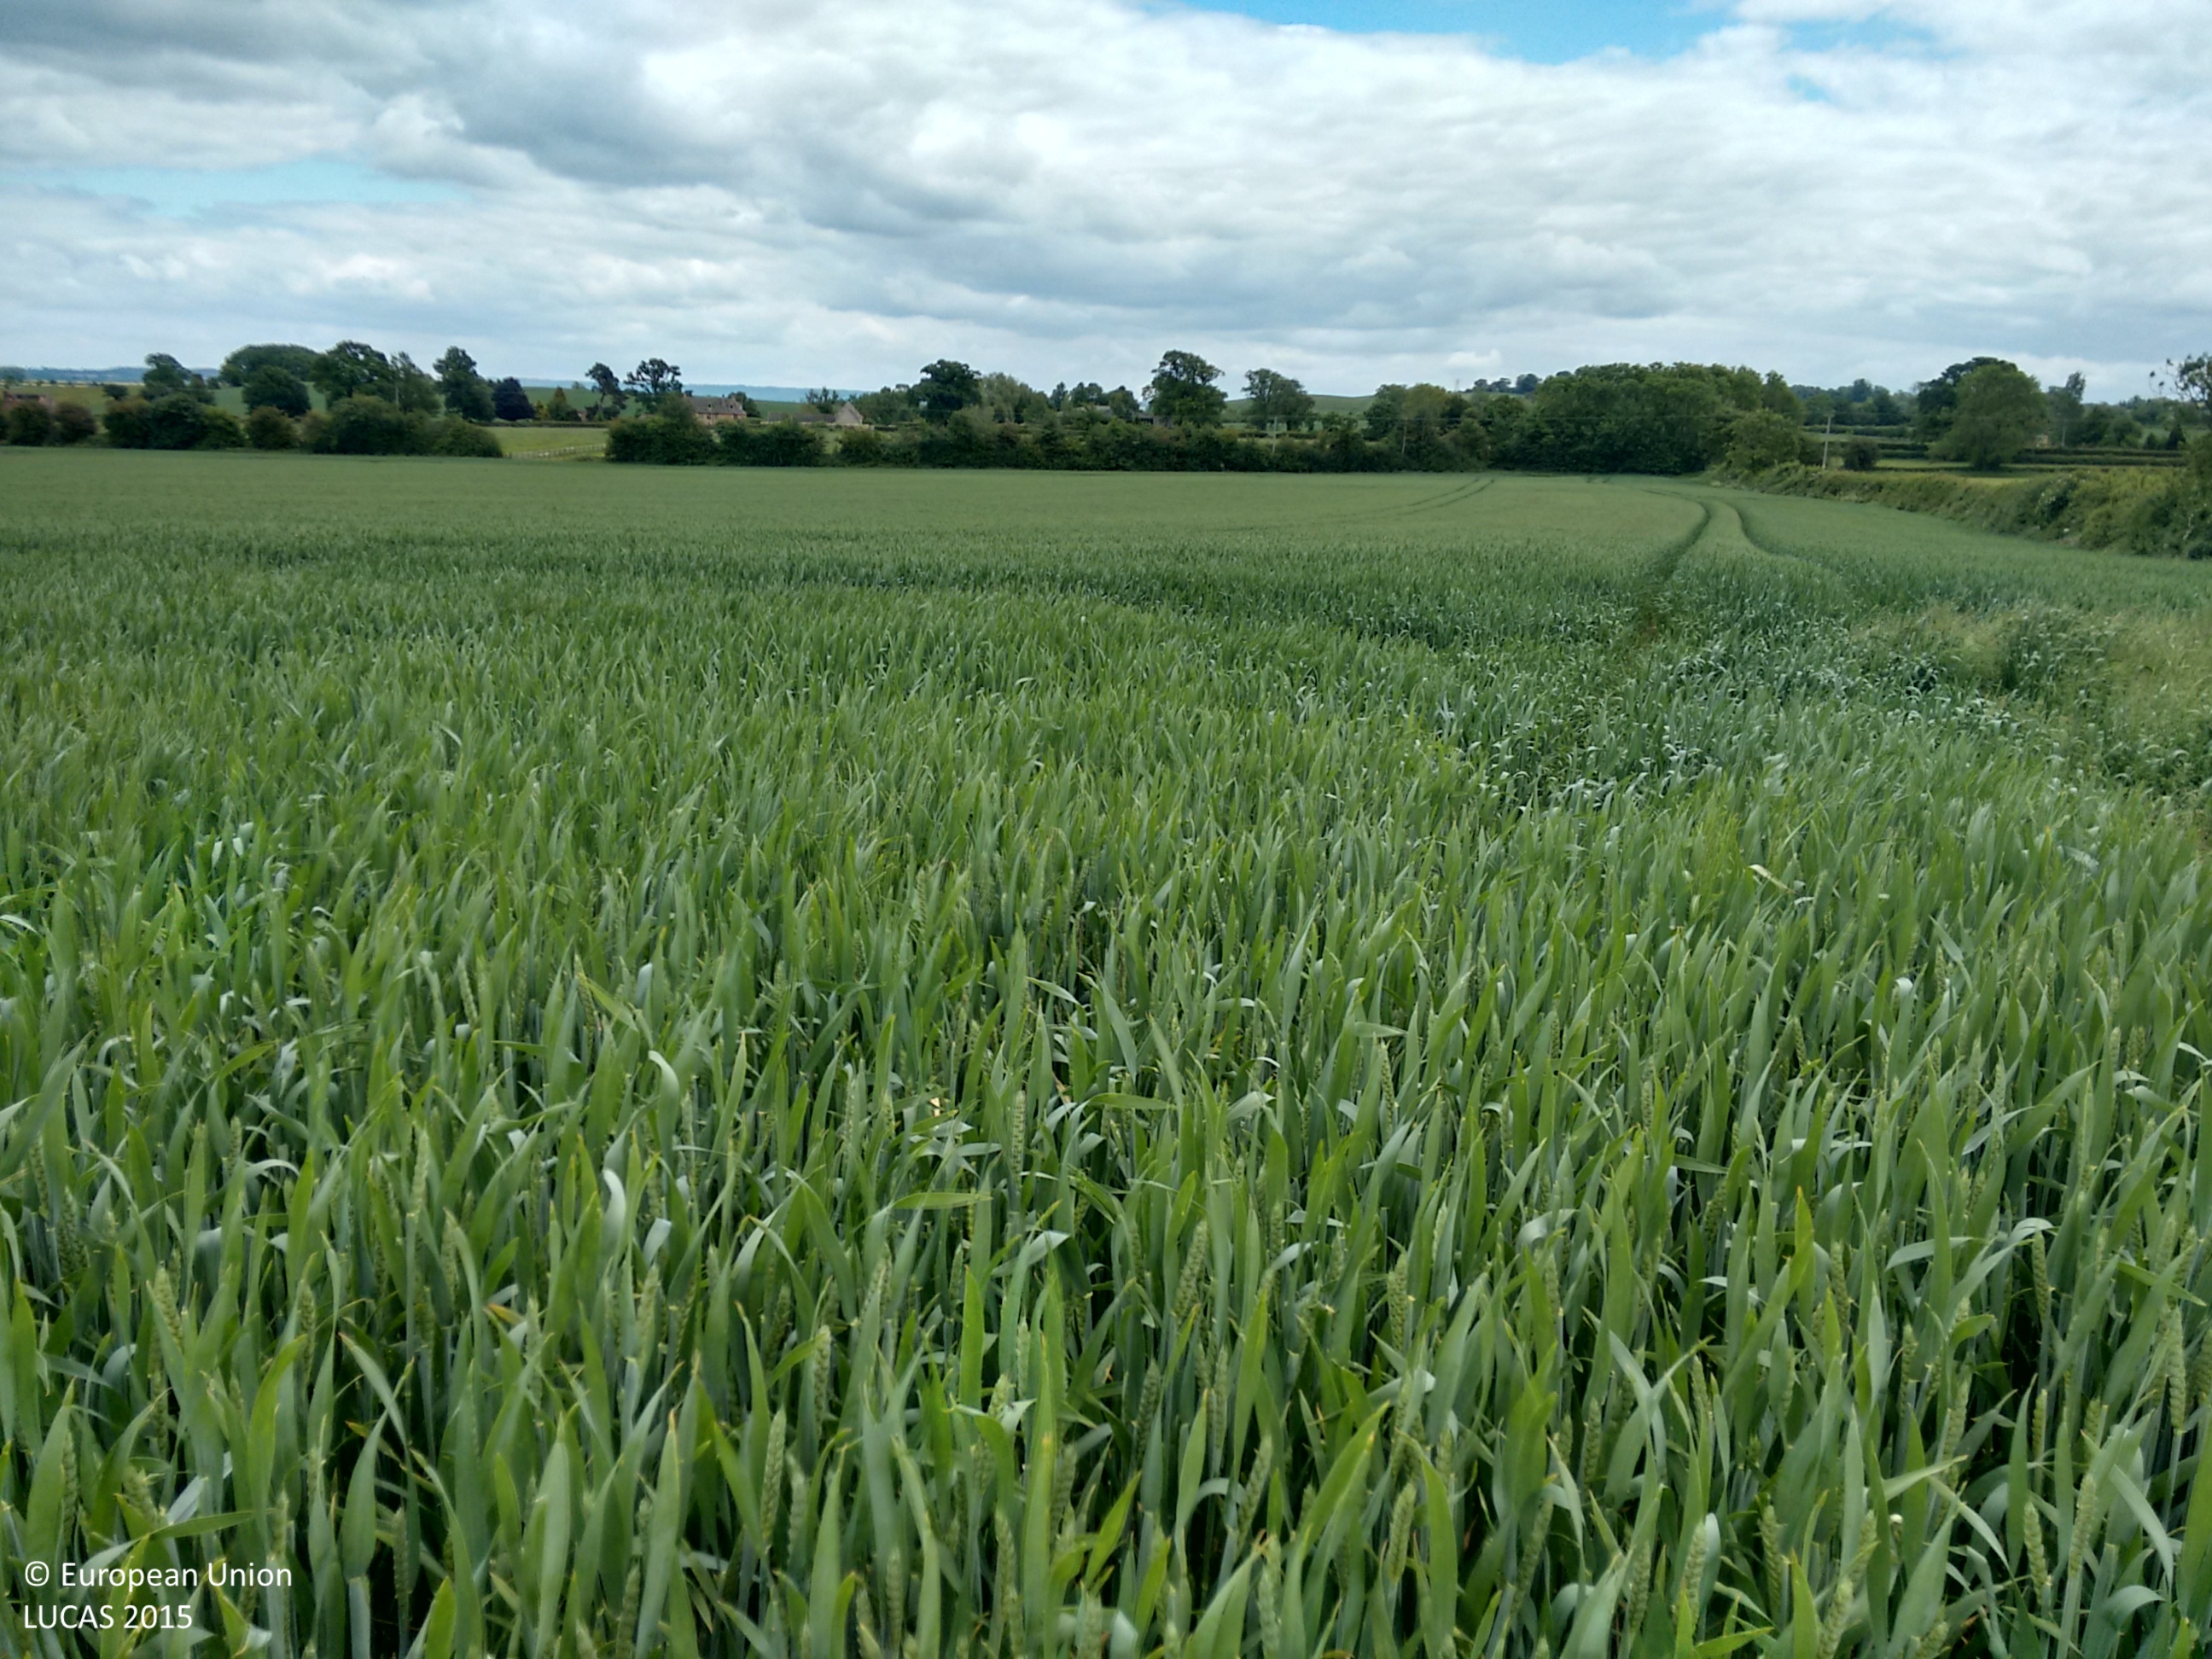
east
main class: Cropland
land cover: Common wheat
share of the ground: > 75 %
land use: Agriculture (excluding fallow land and kitchen gardens)
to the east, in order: Common wheat; Managed hedges; Arable land (only in case pi)
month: June
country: GB
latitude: 52.1036
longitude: -1.7193
